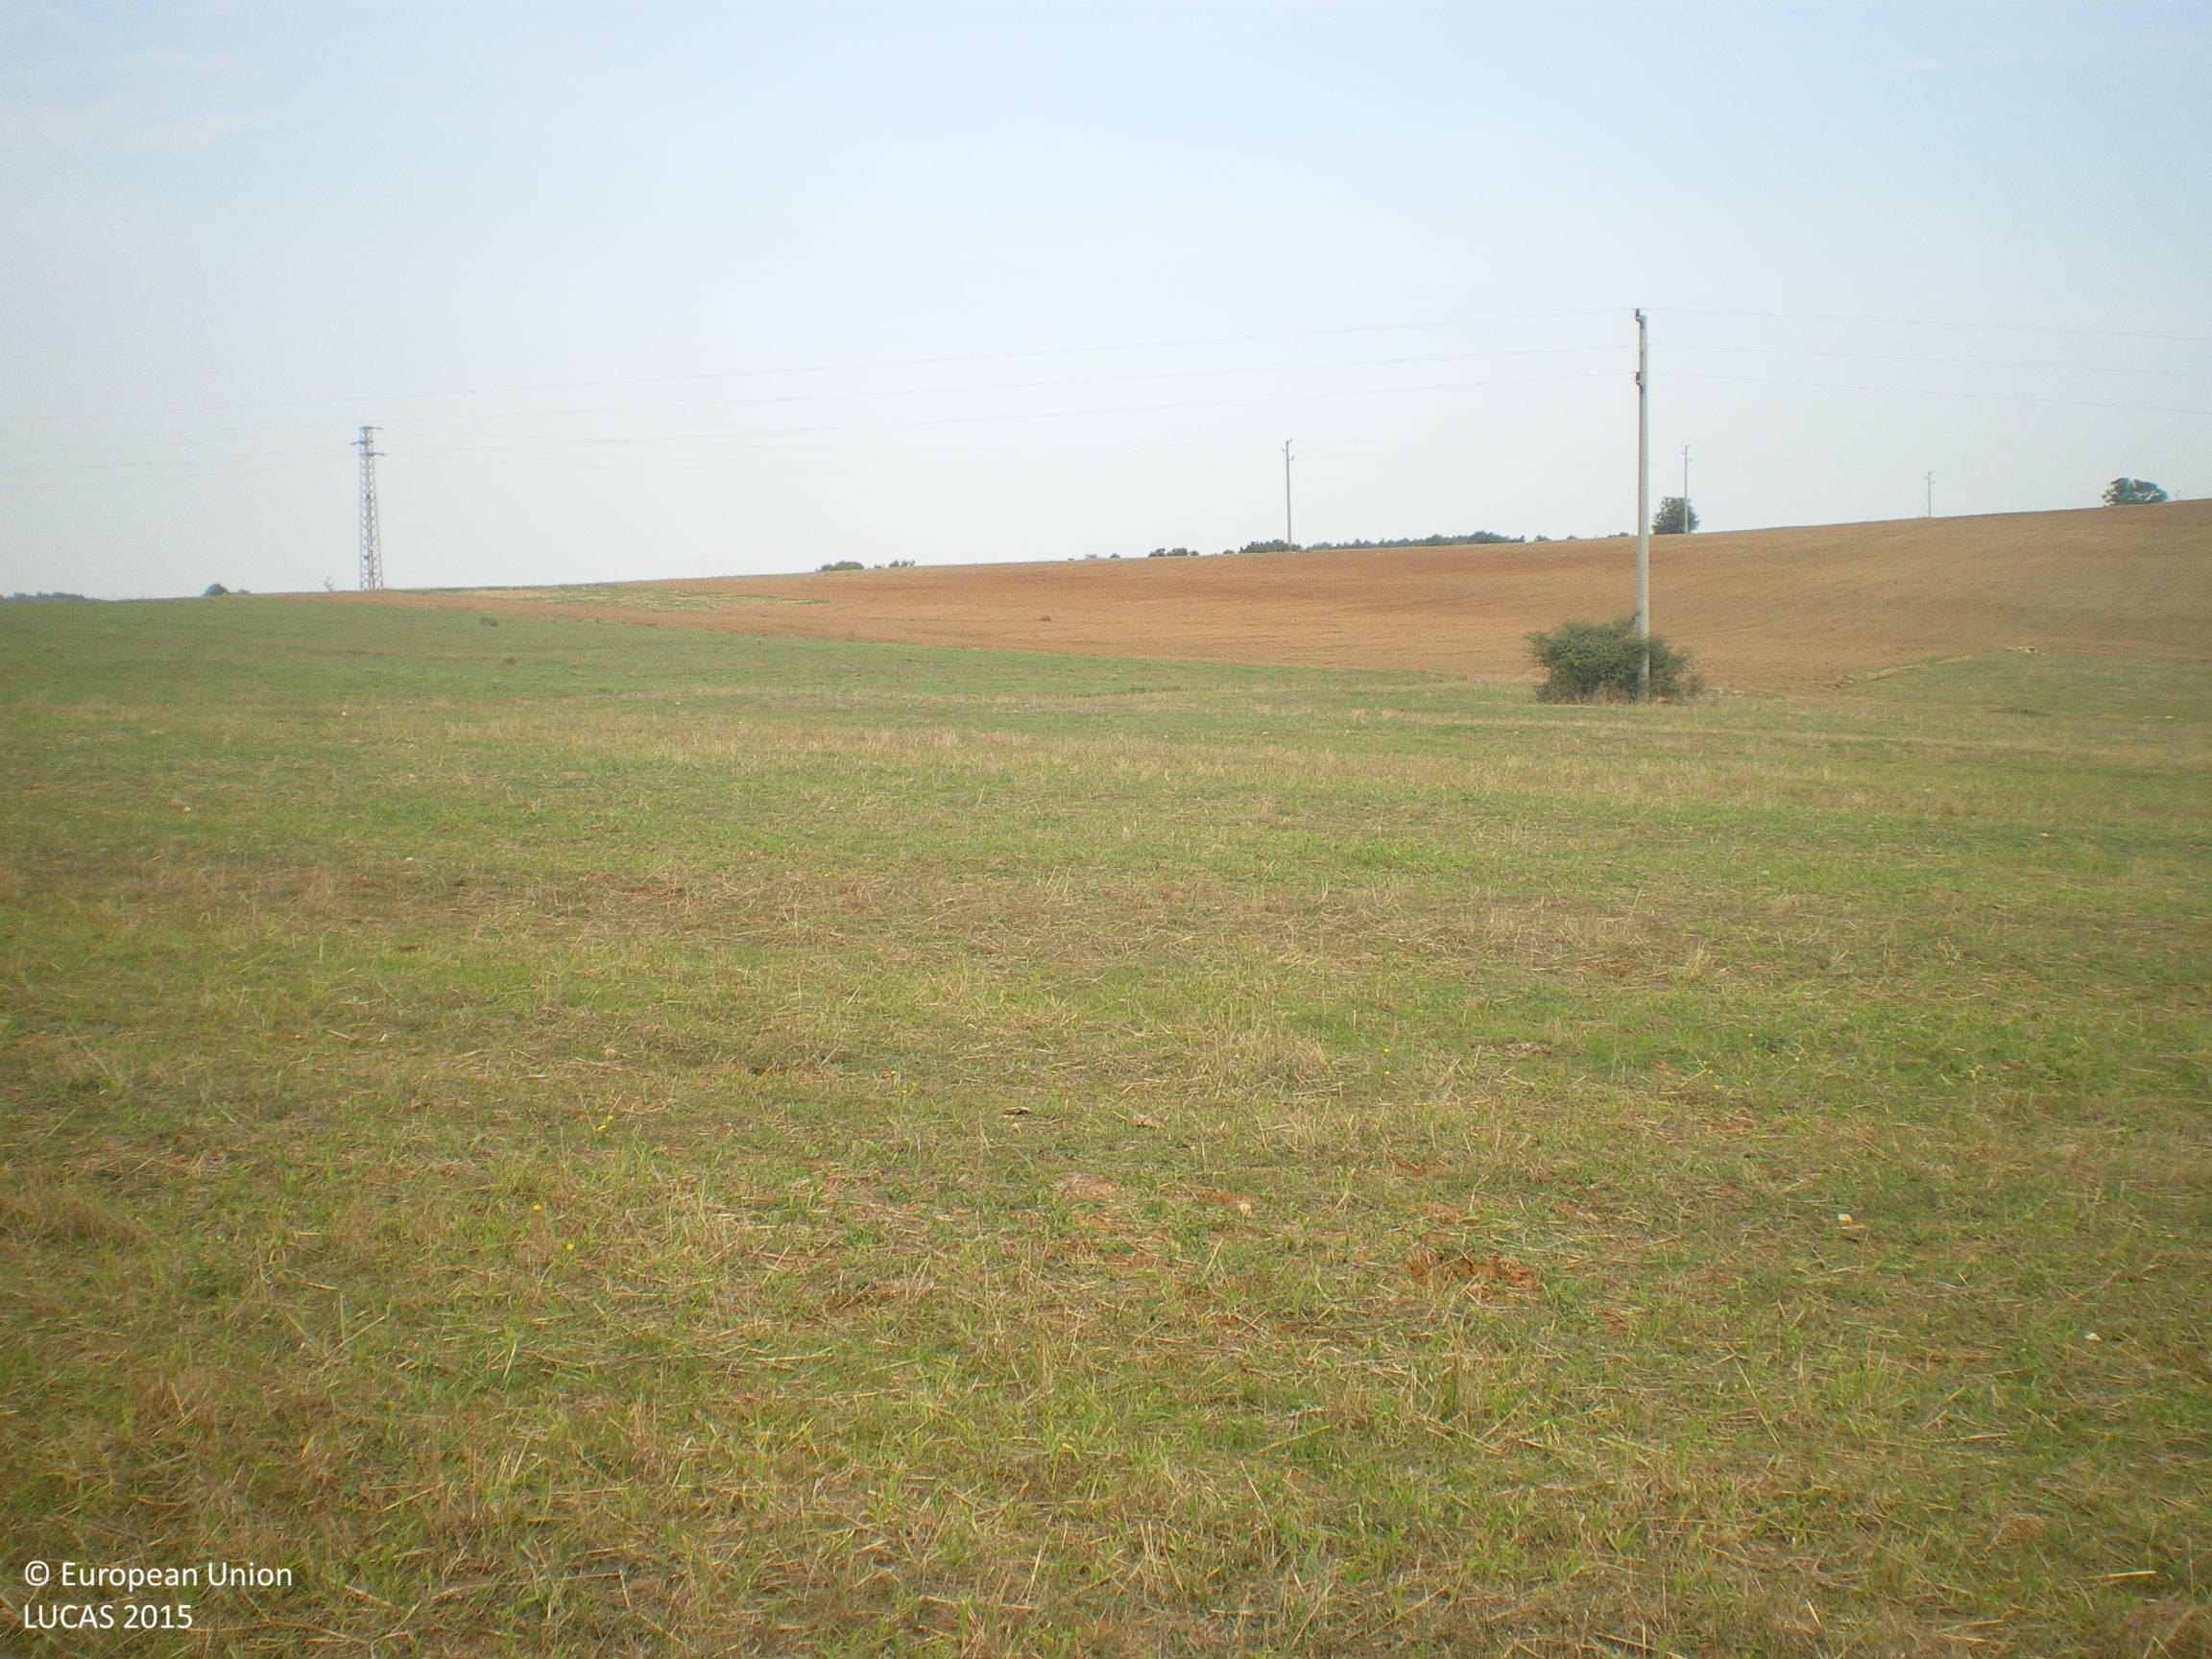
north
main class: Cropland
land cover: Common wheat
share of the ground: < 10 %
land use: Agriculture (excluding fallow land and kitchen gardens)
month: September
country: BG
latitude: 41.8819
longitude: 25.9176
